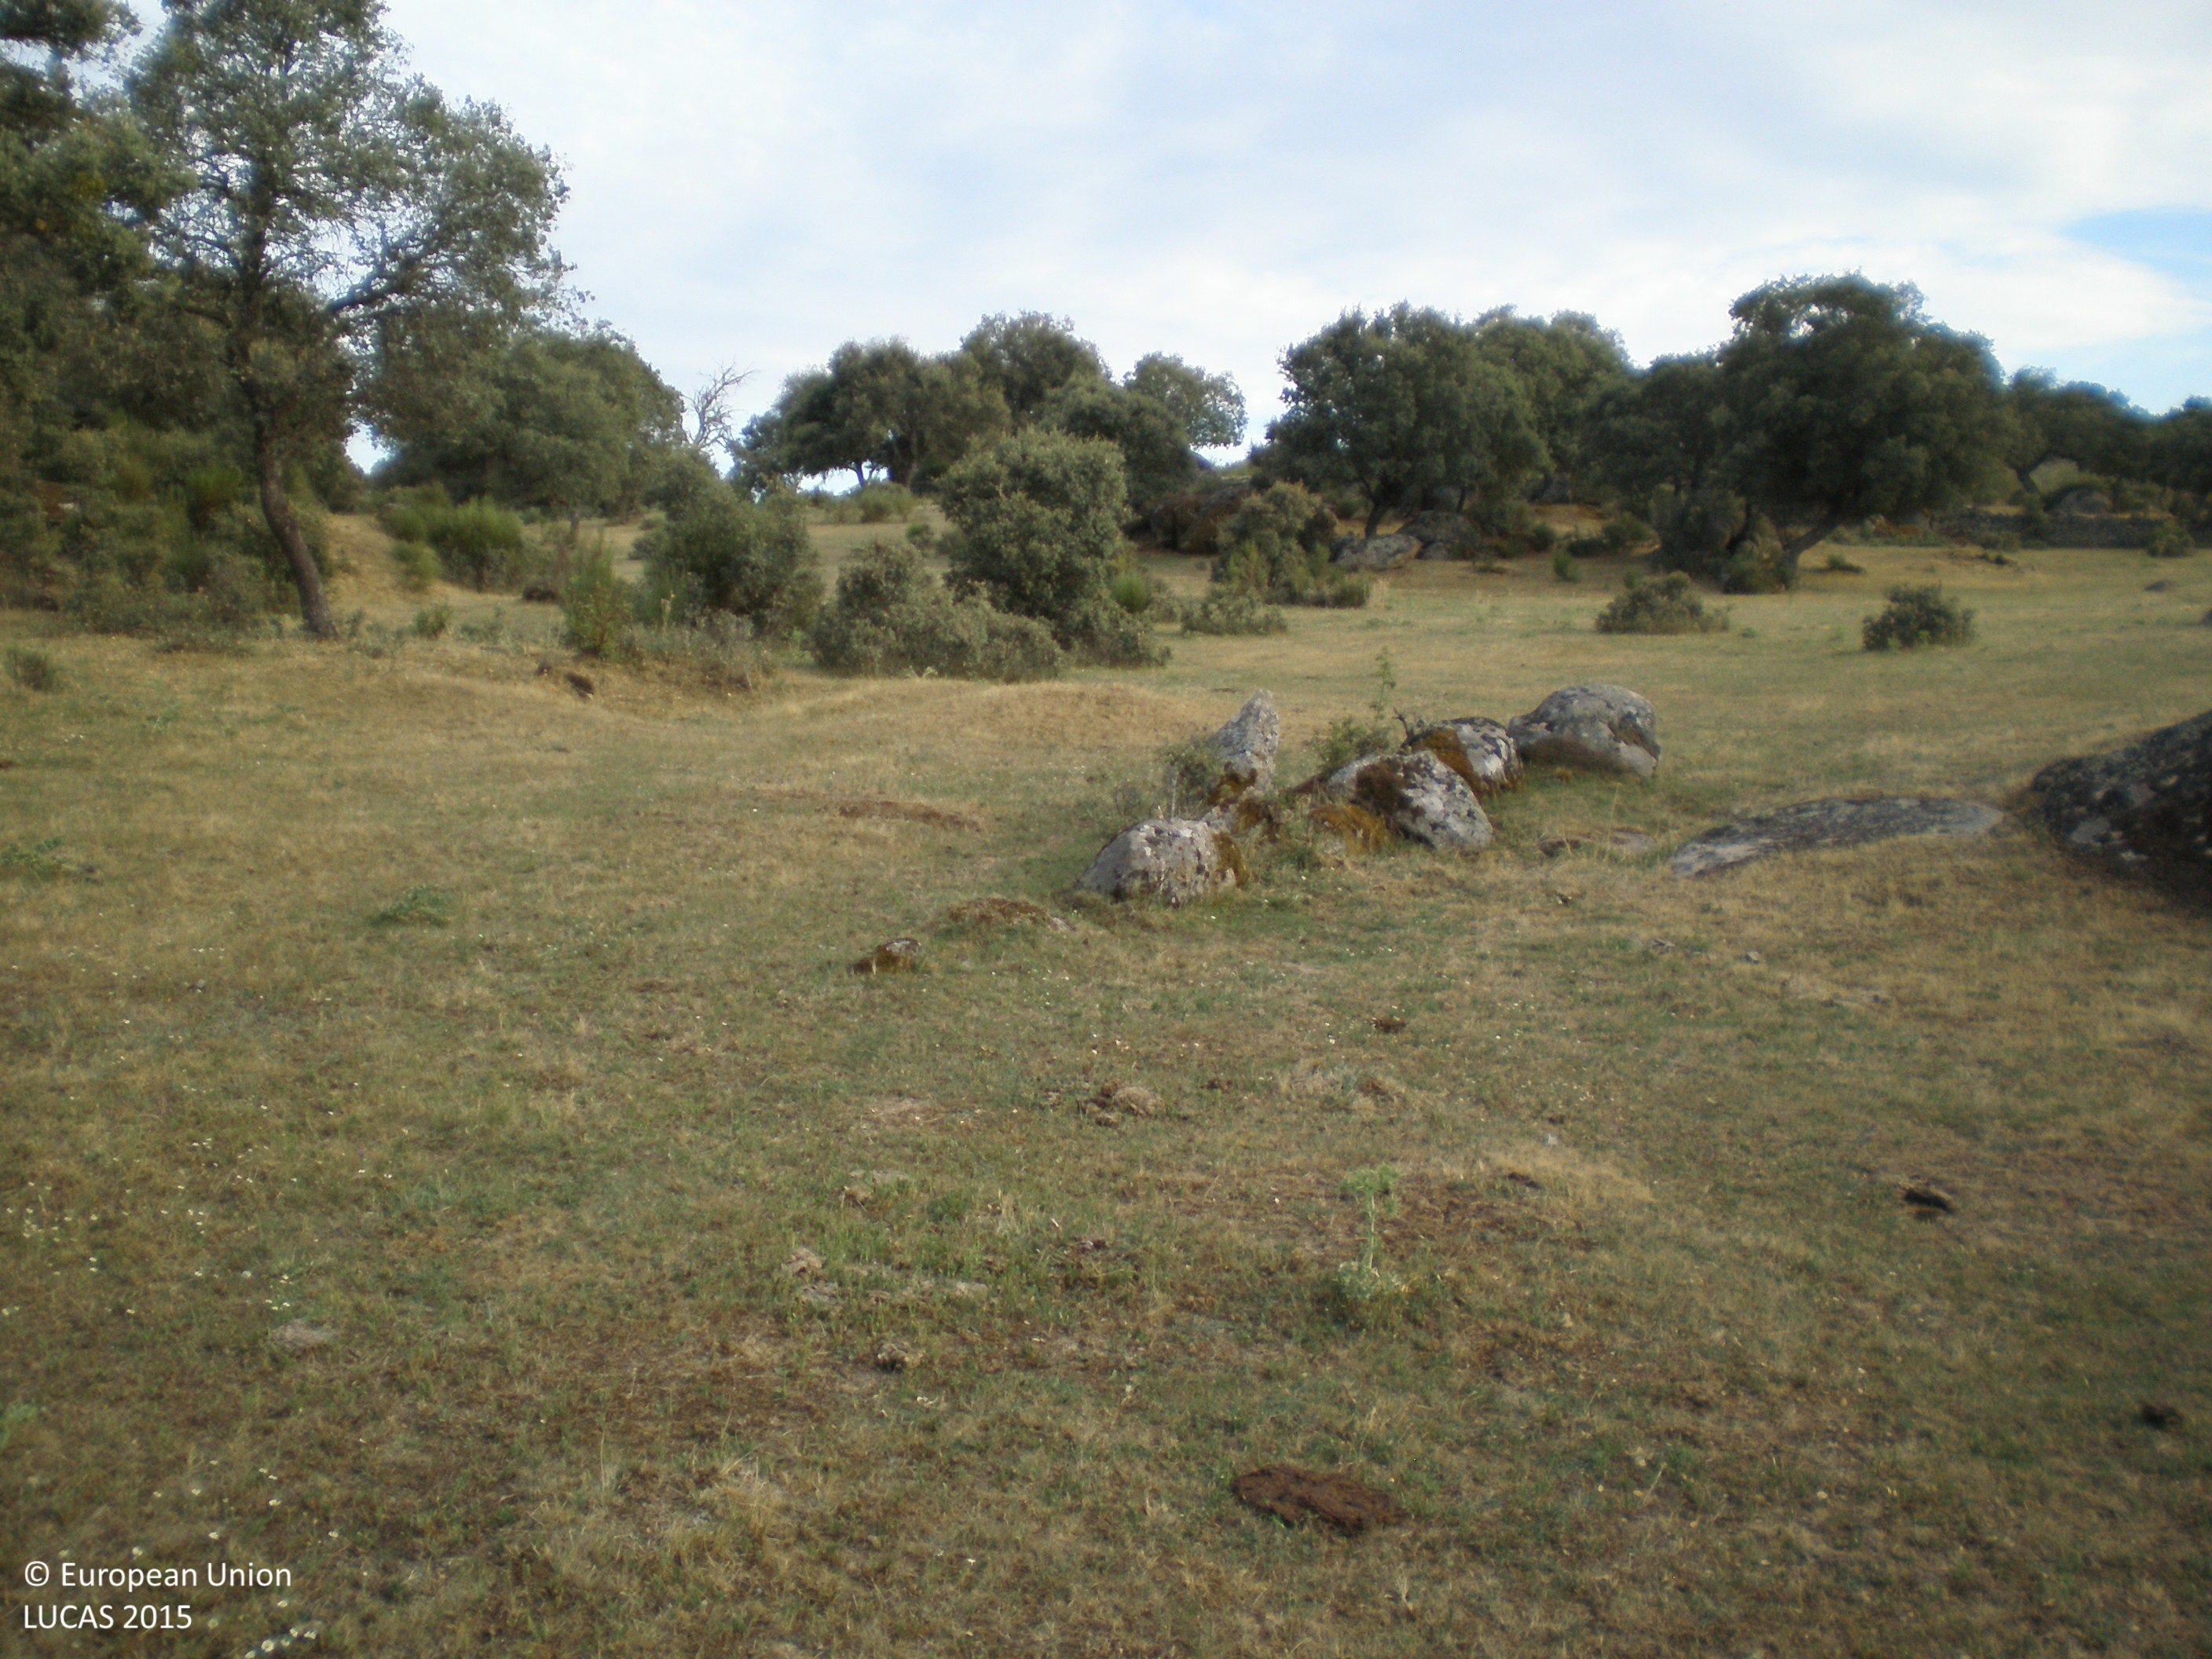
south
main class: Grassland
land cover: Grassland with sparse tree/shrub cover
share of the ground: > 75 %
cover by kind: herbaceous plants 95 %, broadleaved forest trees 5 %
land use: Agriculture (excluding fallow land and kitchen gardens)
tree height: < 5 m
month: July
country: ES
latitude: 40.5160
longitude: -5.6137
